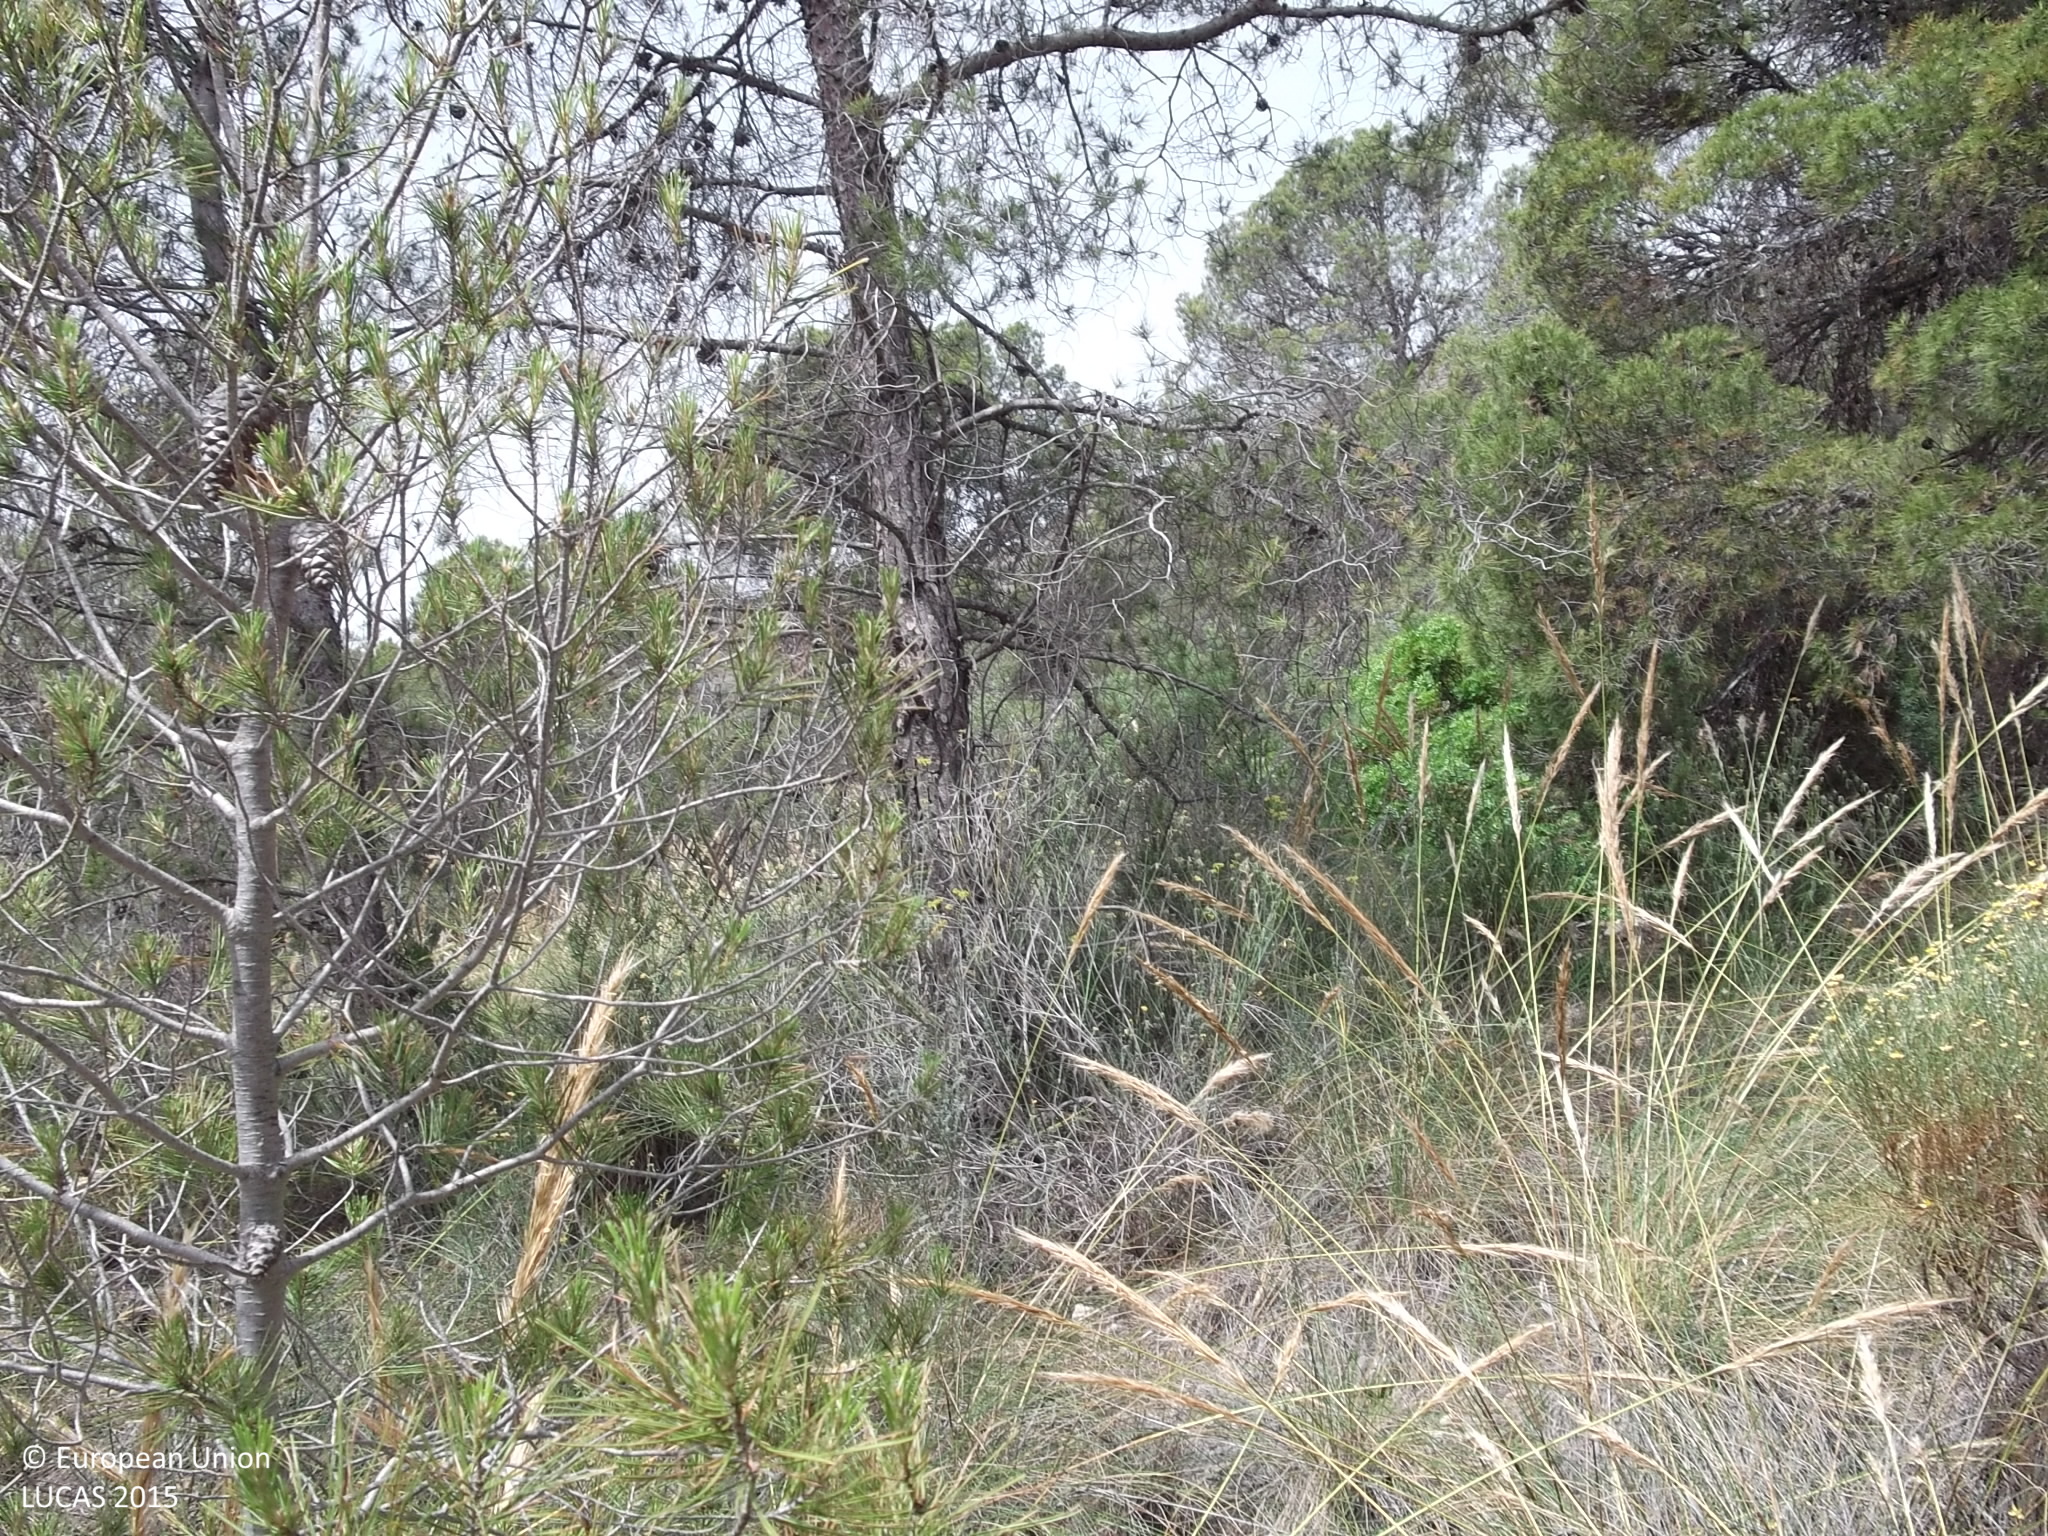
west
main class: Woodland
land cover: Pine dominated coniferous woodland
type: coniferous forest of the mediterranean region
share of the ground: 25 - 50 %
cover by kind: coniferous forest trees 35 %, shrubs 35 %, herbaceous plants 20 %, consolidated bare surface 10 %
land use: Semi-natural and natural areas not in use
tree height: > 5 m
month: May
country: ES
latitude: 38.4358
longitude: -1.6661
